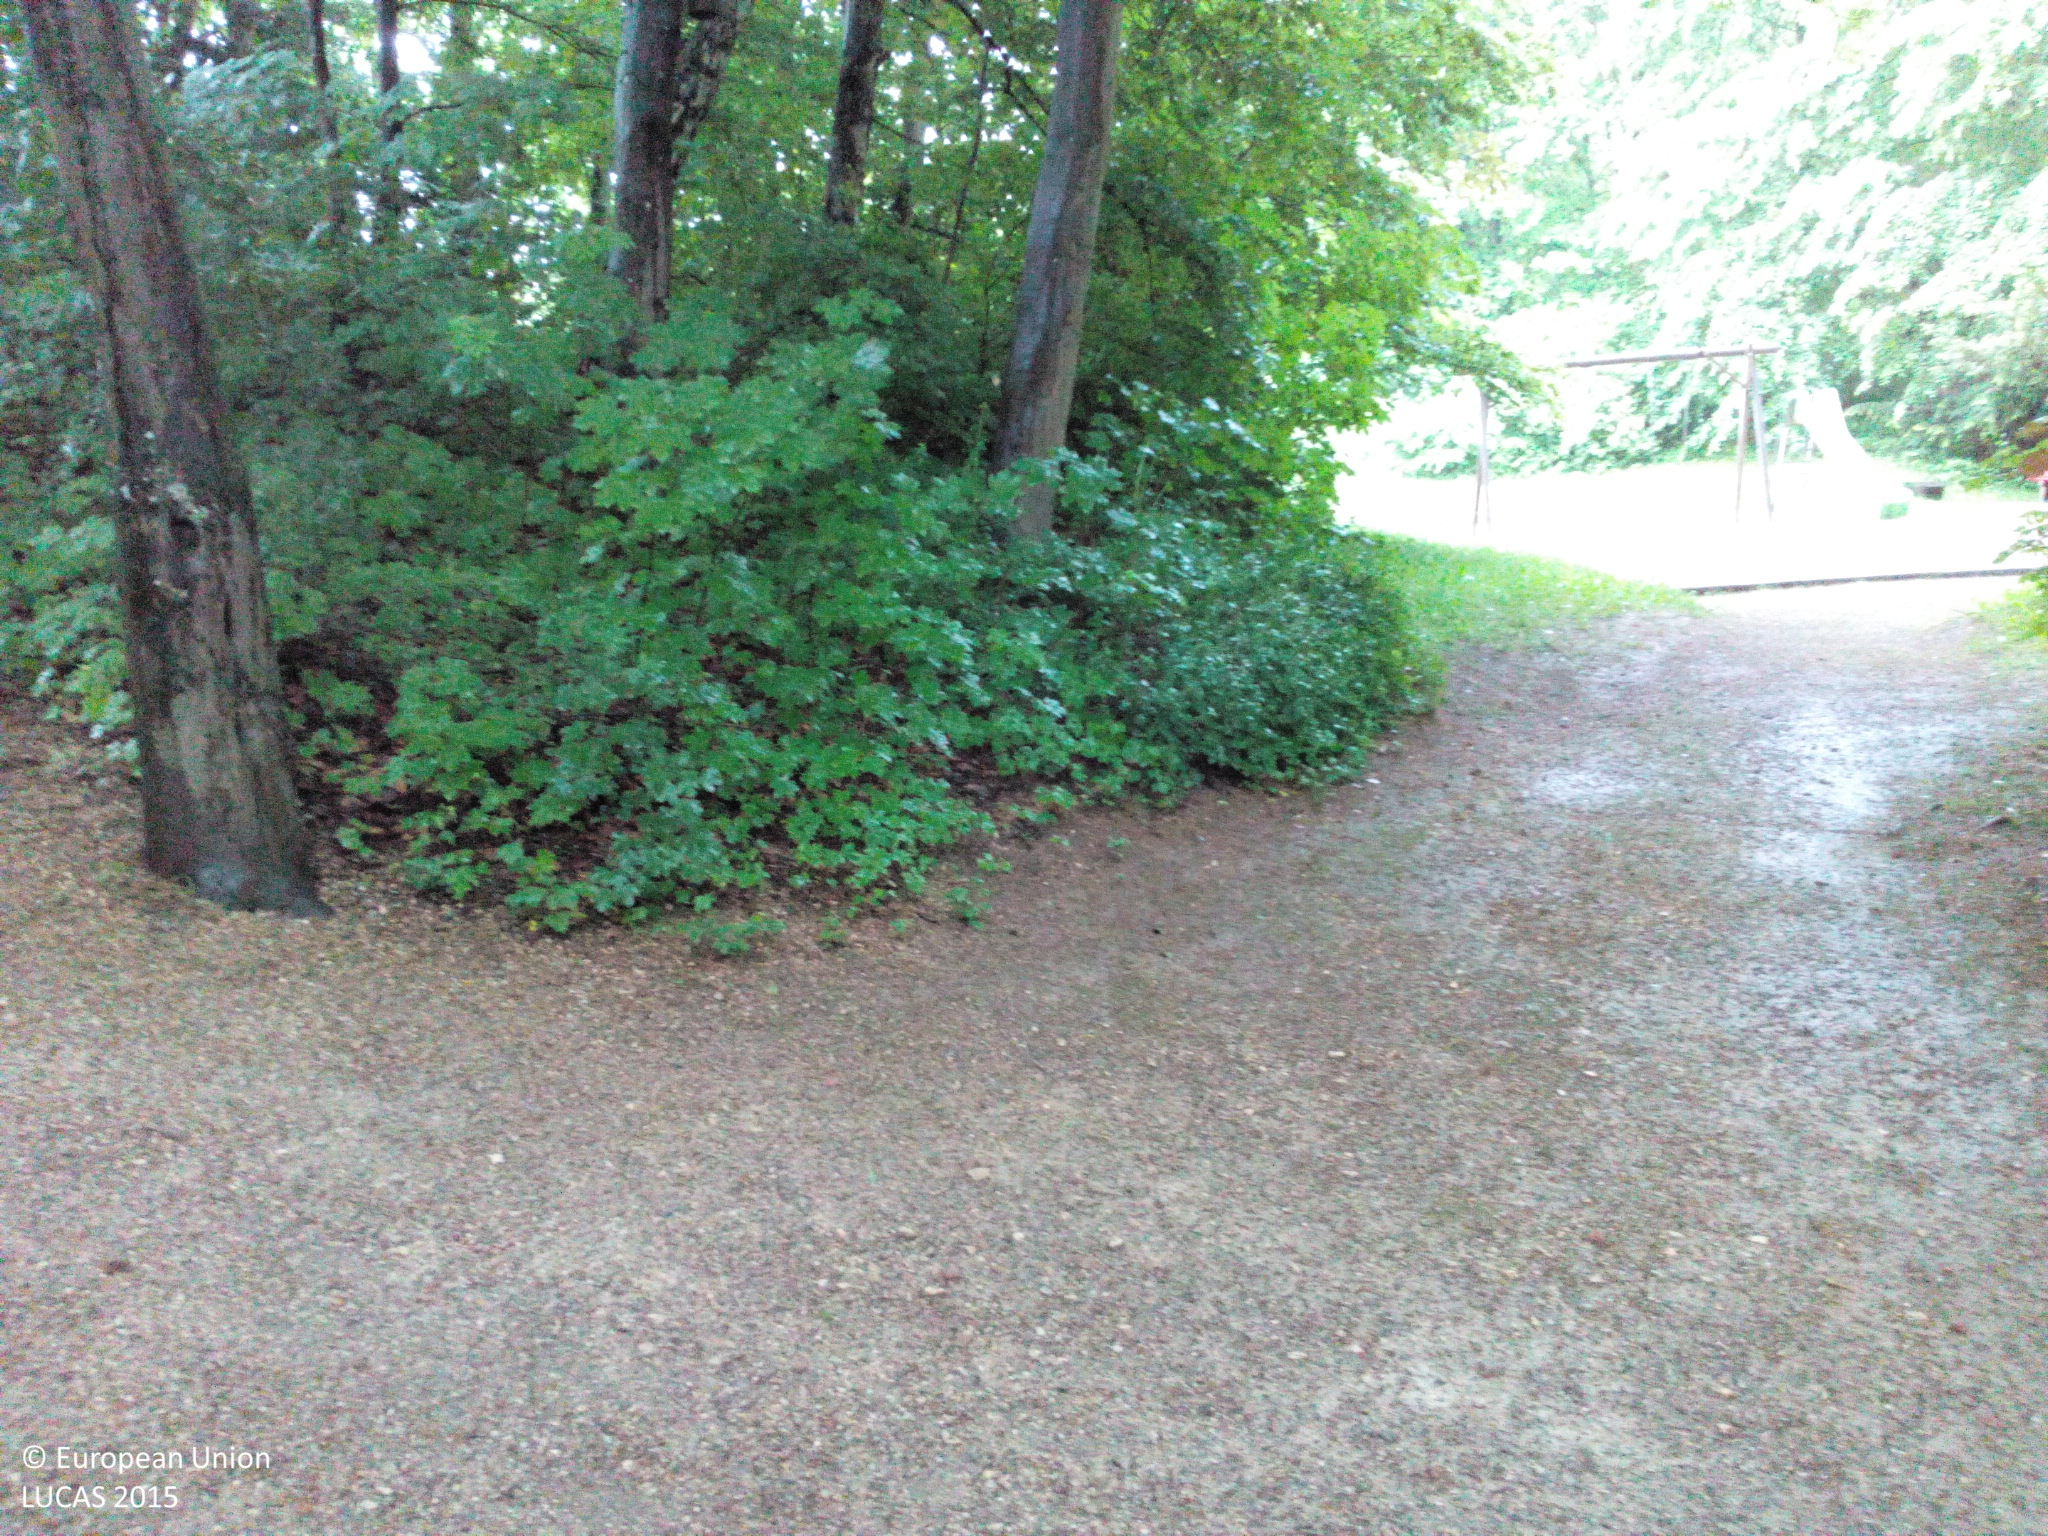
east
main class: Woodland
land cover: Broadleaved woodland
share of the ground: > 75 %
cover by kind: broadleaved forest trees 70 %, shrubs 15 %, unconsolidated bare surface 10 %, coniferous forest trees 5 %
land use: Road transport
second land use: Amenities, museums, leisure
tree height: > 5 m
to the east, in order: Broadleaved woodland; Tracks; Broadleaved woodland; Grassland without tree/shrub cover; Artificial constructions in urban areas
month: May
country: DE
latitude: 49.0316
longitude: 12.0920
